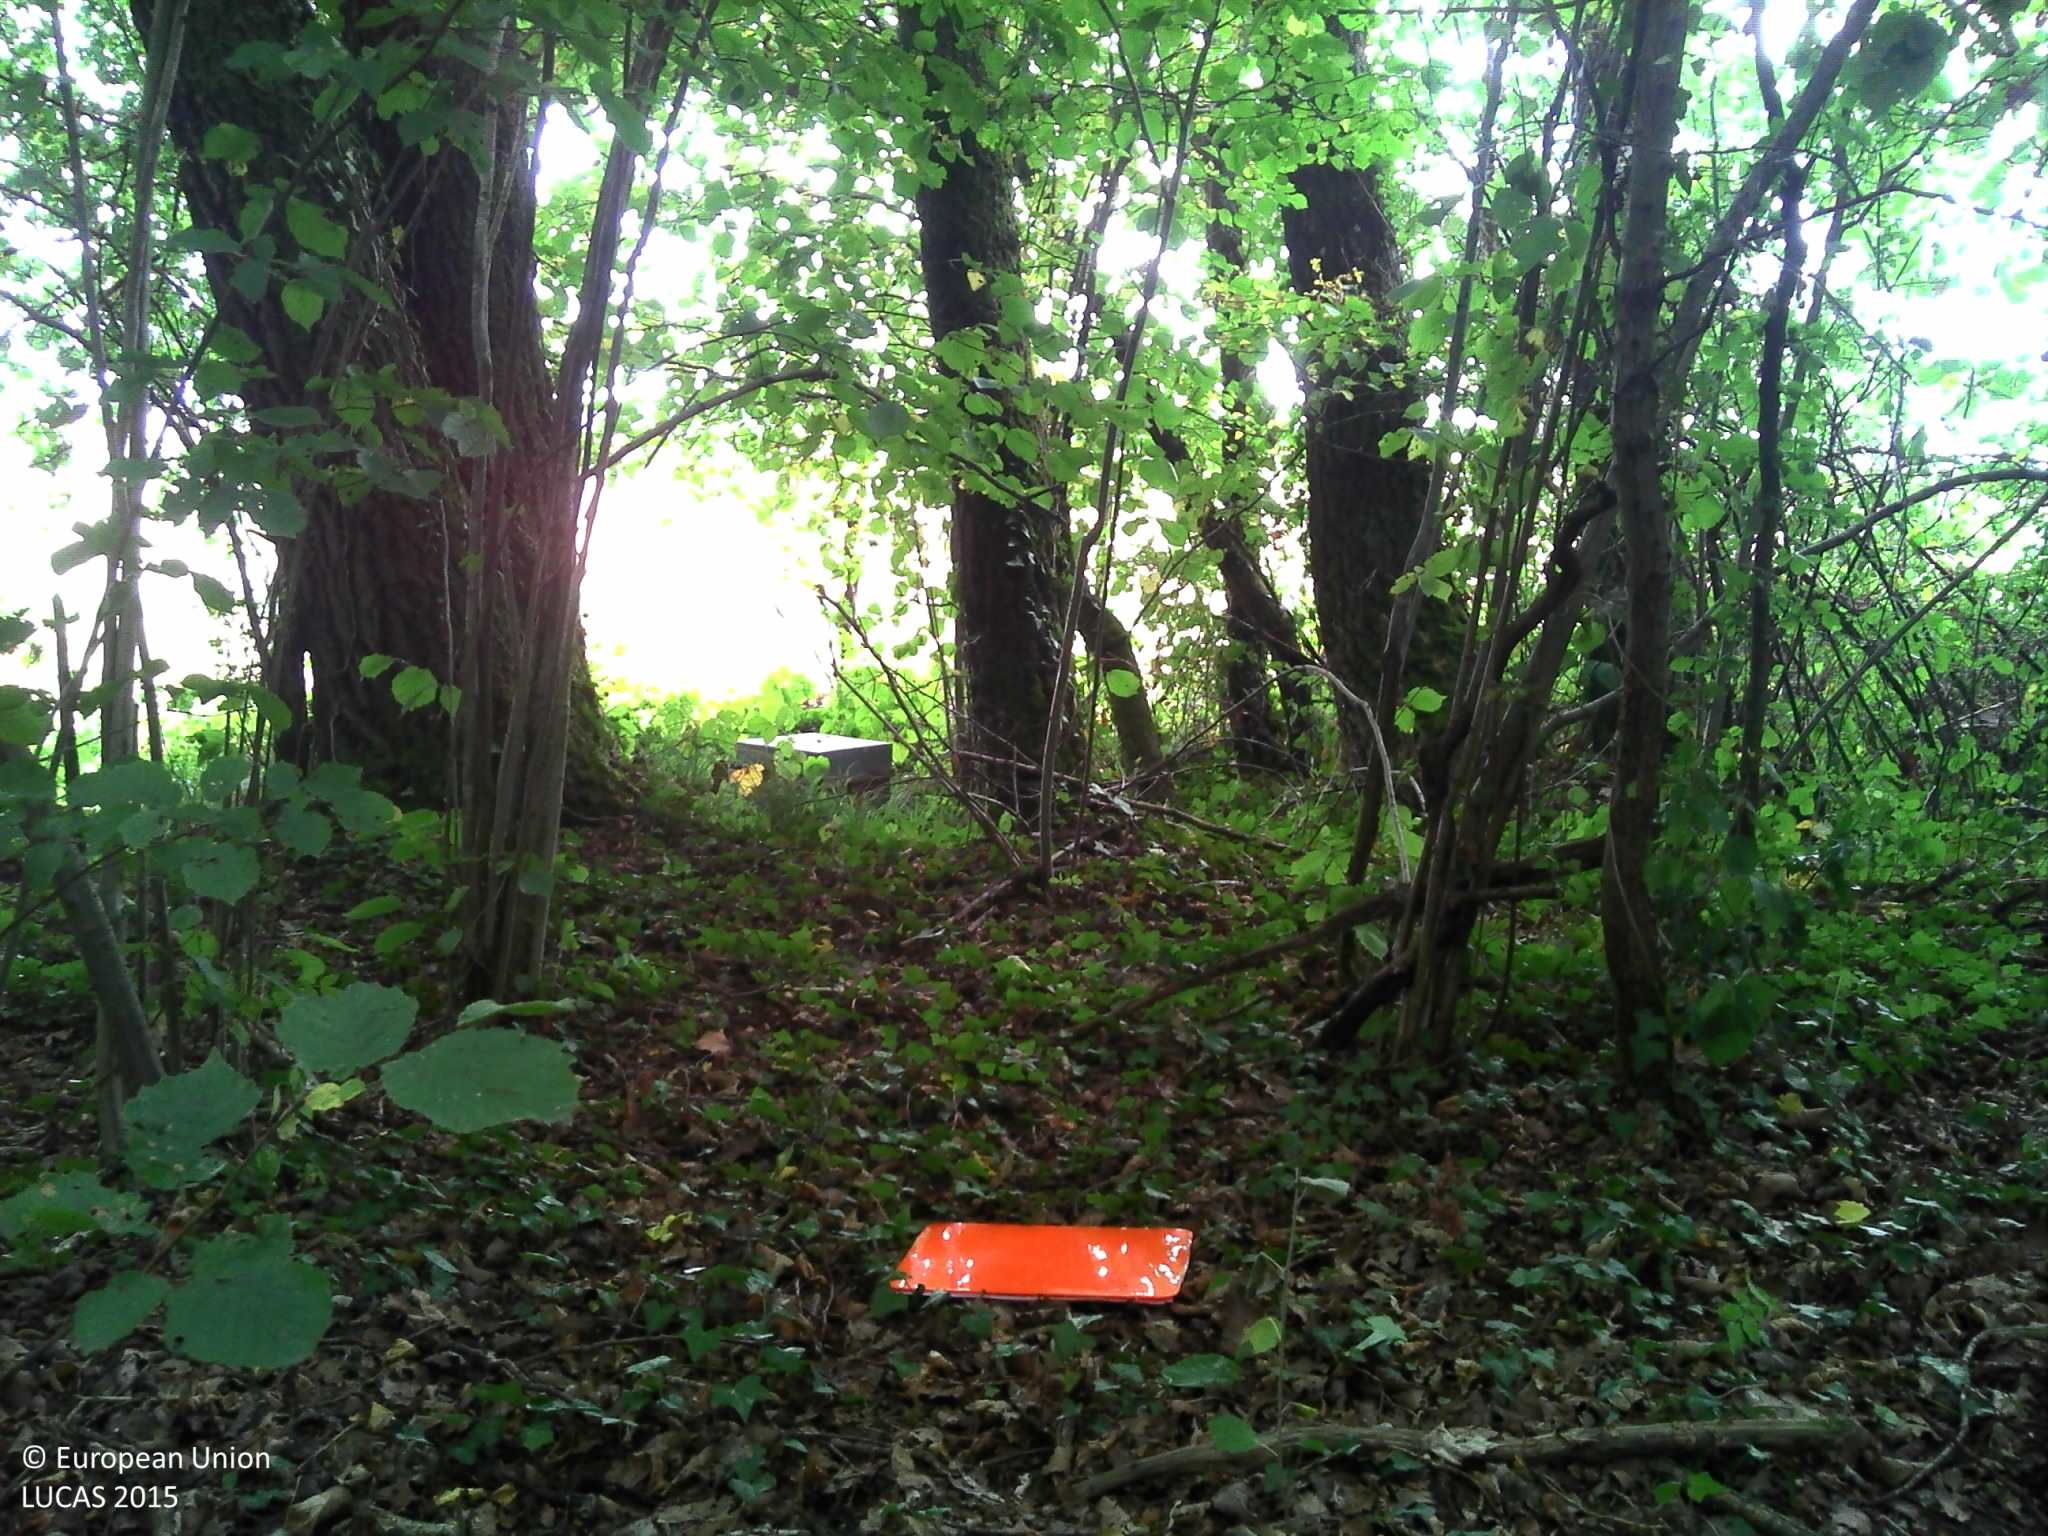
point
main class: Woodland
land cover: Broadleaved woodland
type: mesophytic deciduous forest
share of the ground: > 75 %
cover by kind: broadleaved forest trees 40 %, herbaceous plants 35 %, unconsolidated bare surface 15 %, lichens and mosses 5 %
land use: Forestry
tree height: > 5 m
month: August
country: FR
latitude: 49.2174
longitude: 3.7198
